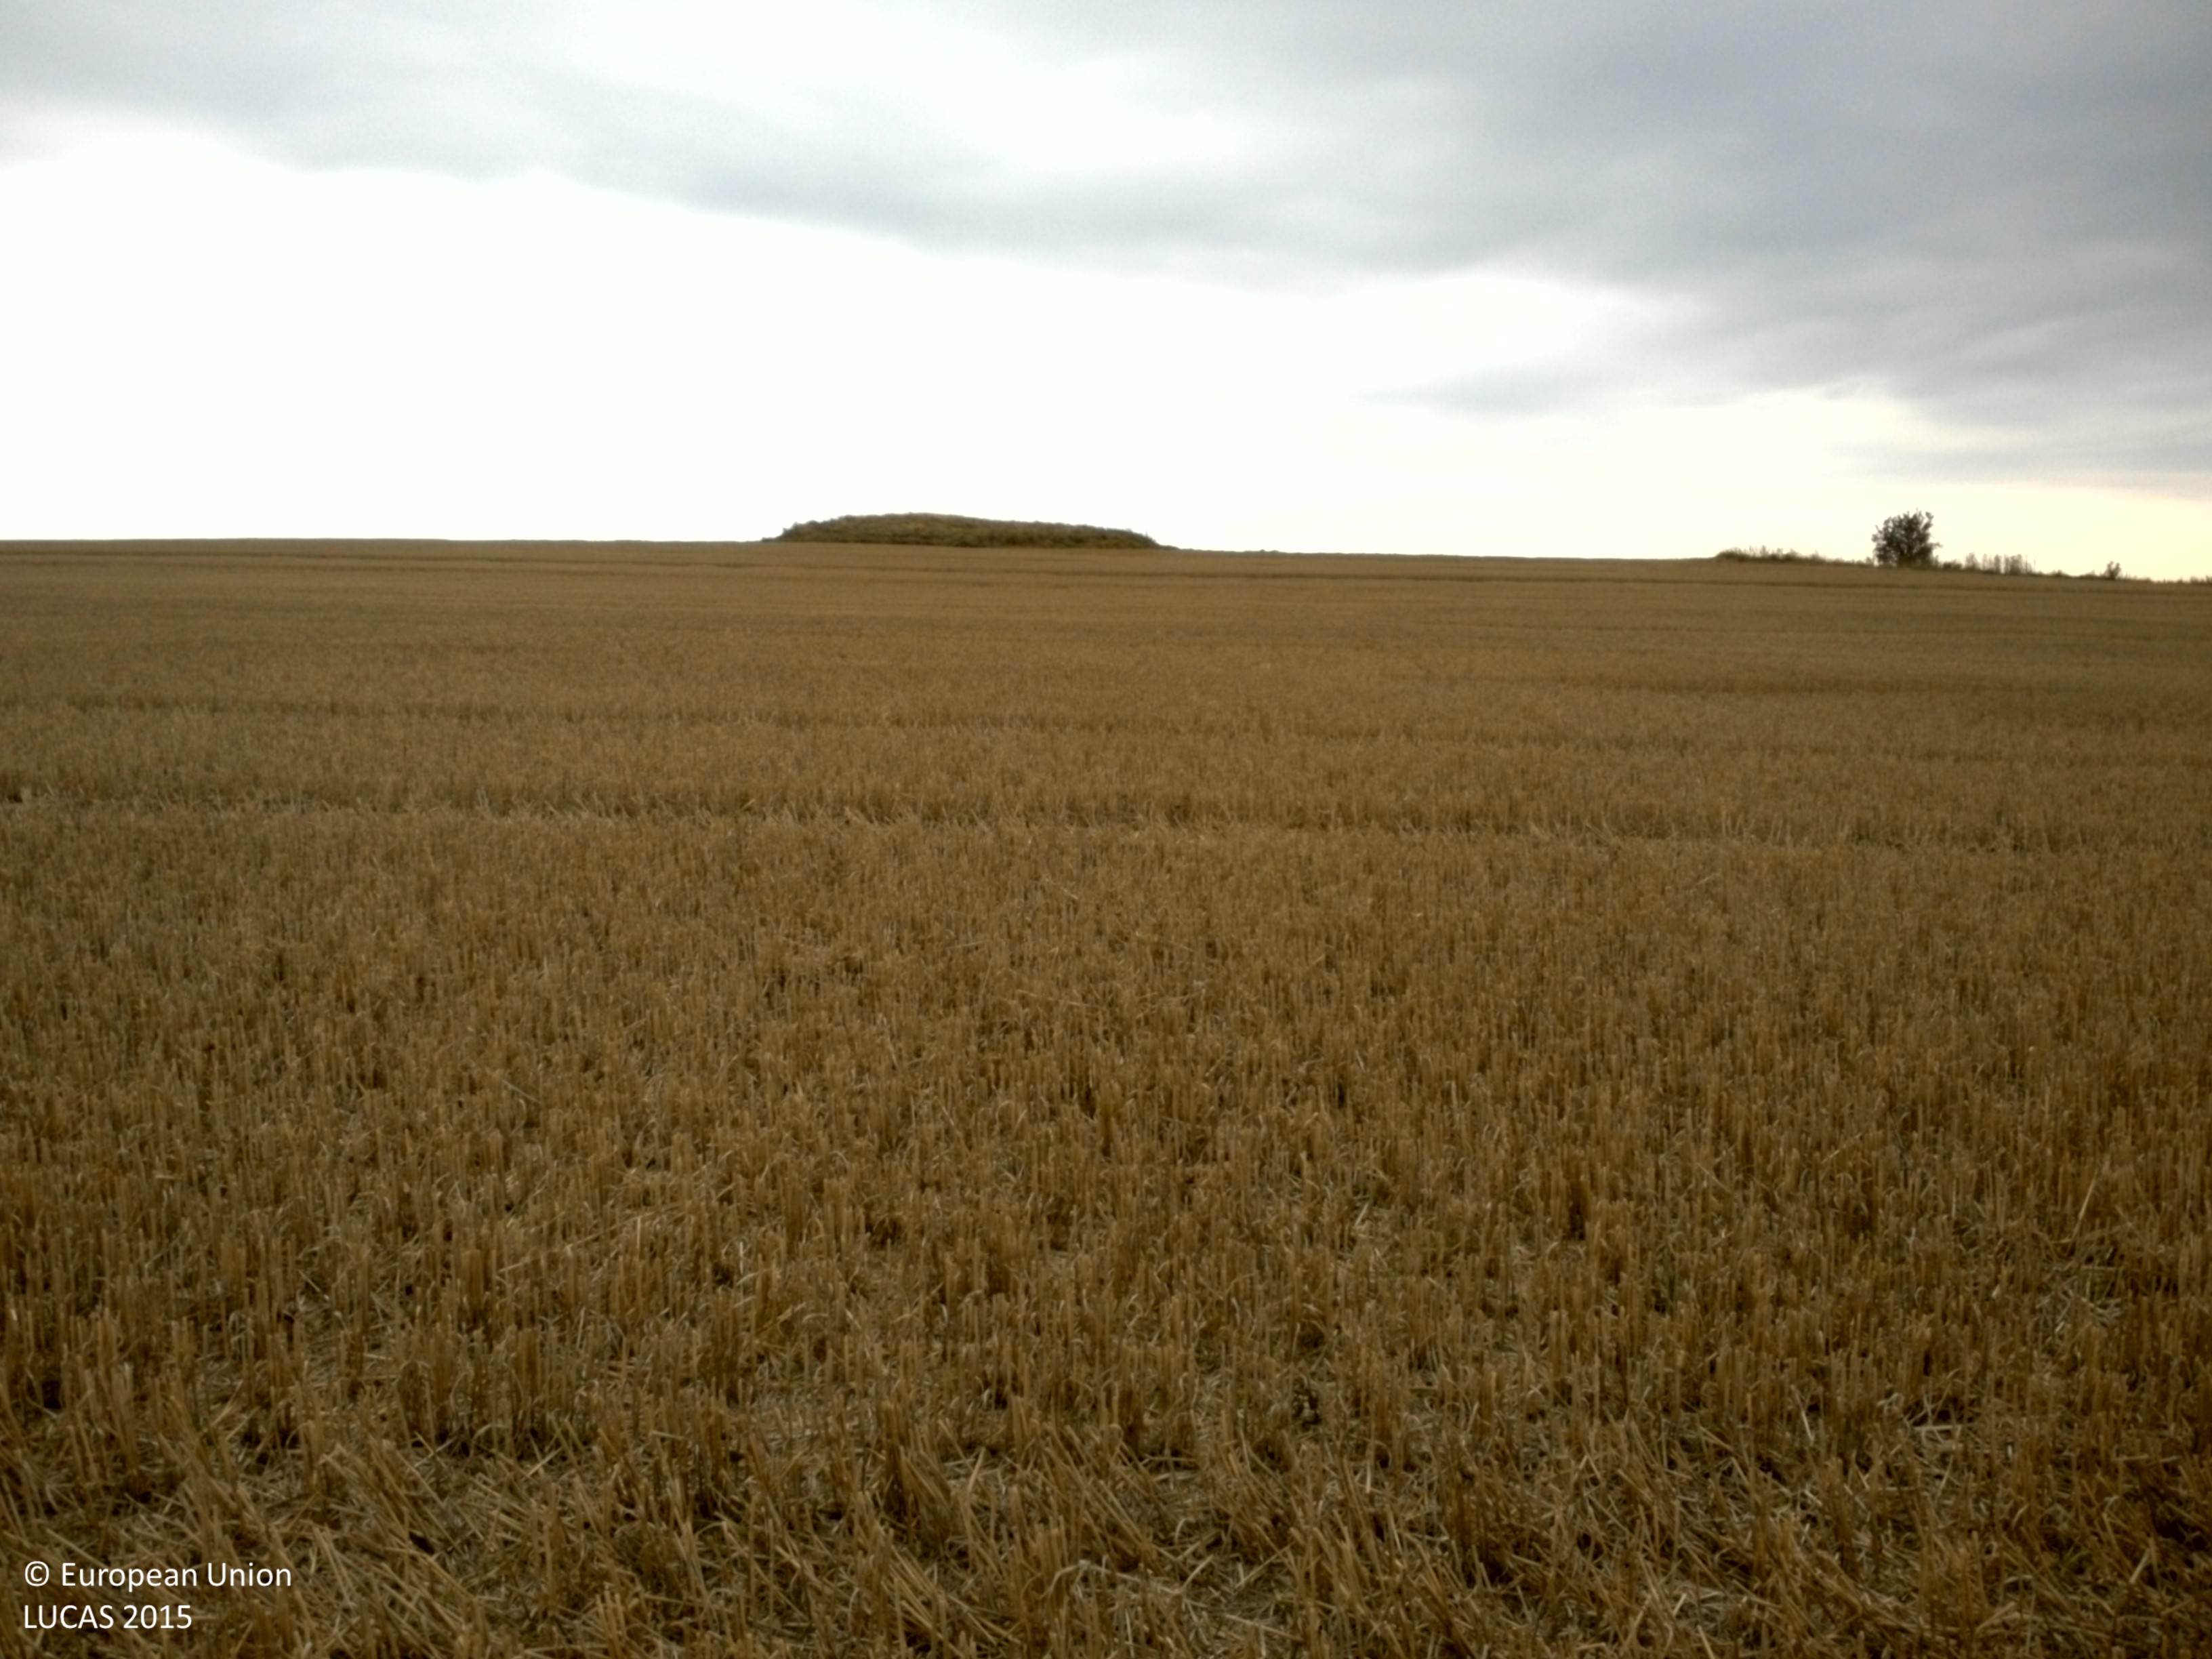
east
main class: Cropland
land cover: Common wheat
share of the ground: 25 - 50 %
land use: Agriculture (excluding fallow land and kitchen gardens)
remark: Harvested field
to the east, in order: Common wheat; Tracks; Mixed cereals for fodder
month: October
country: SE
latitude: 55.8794
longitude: 13.1468
